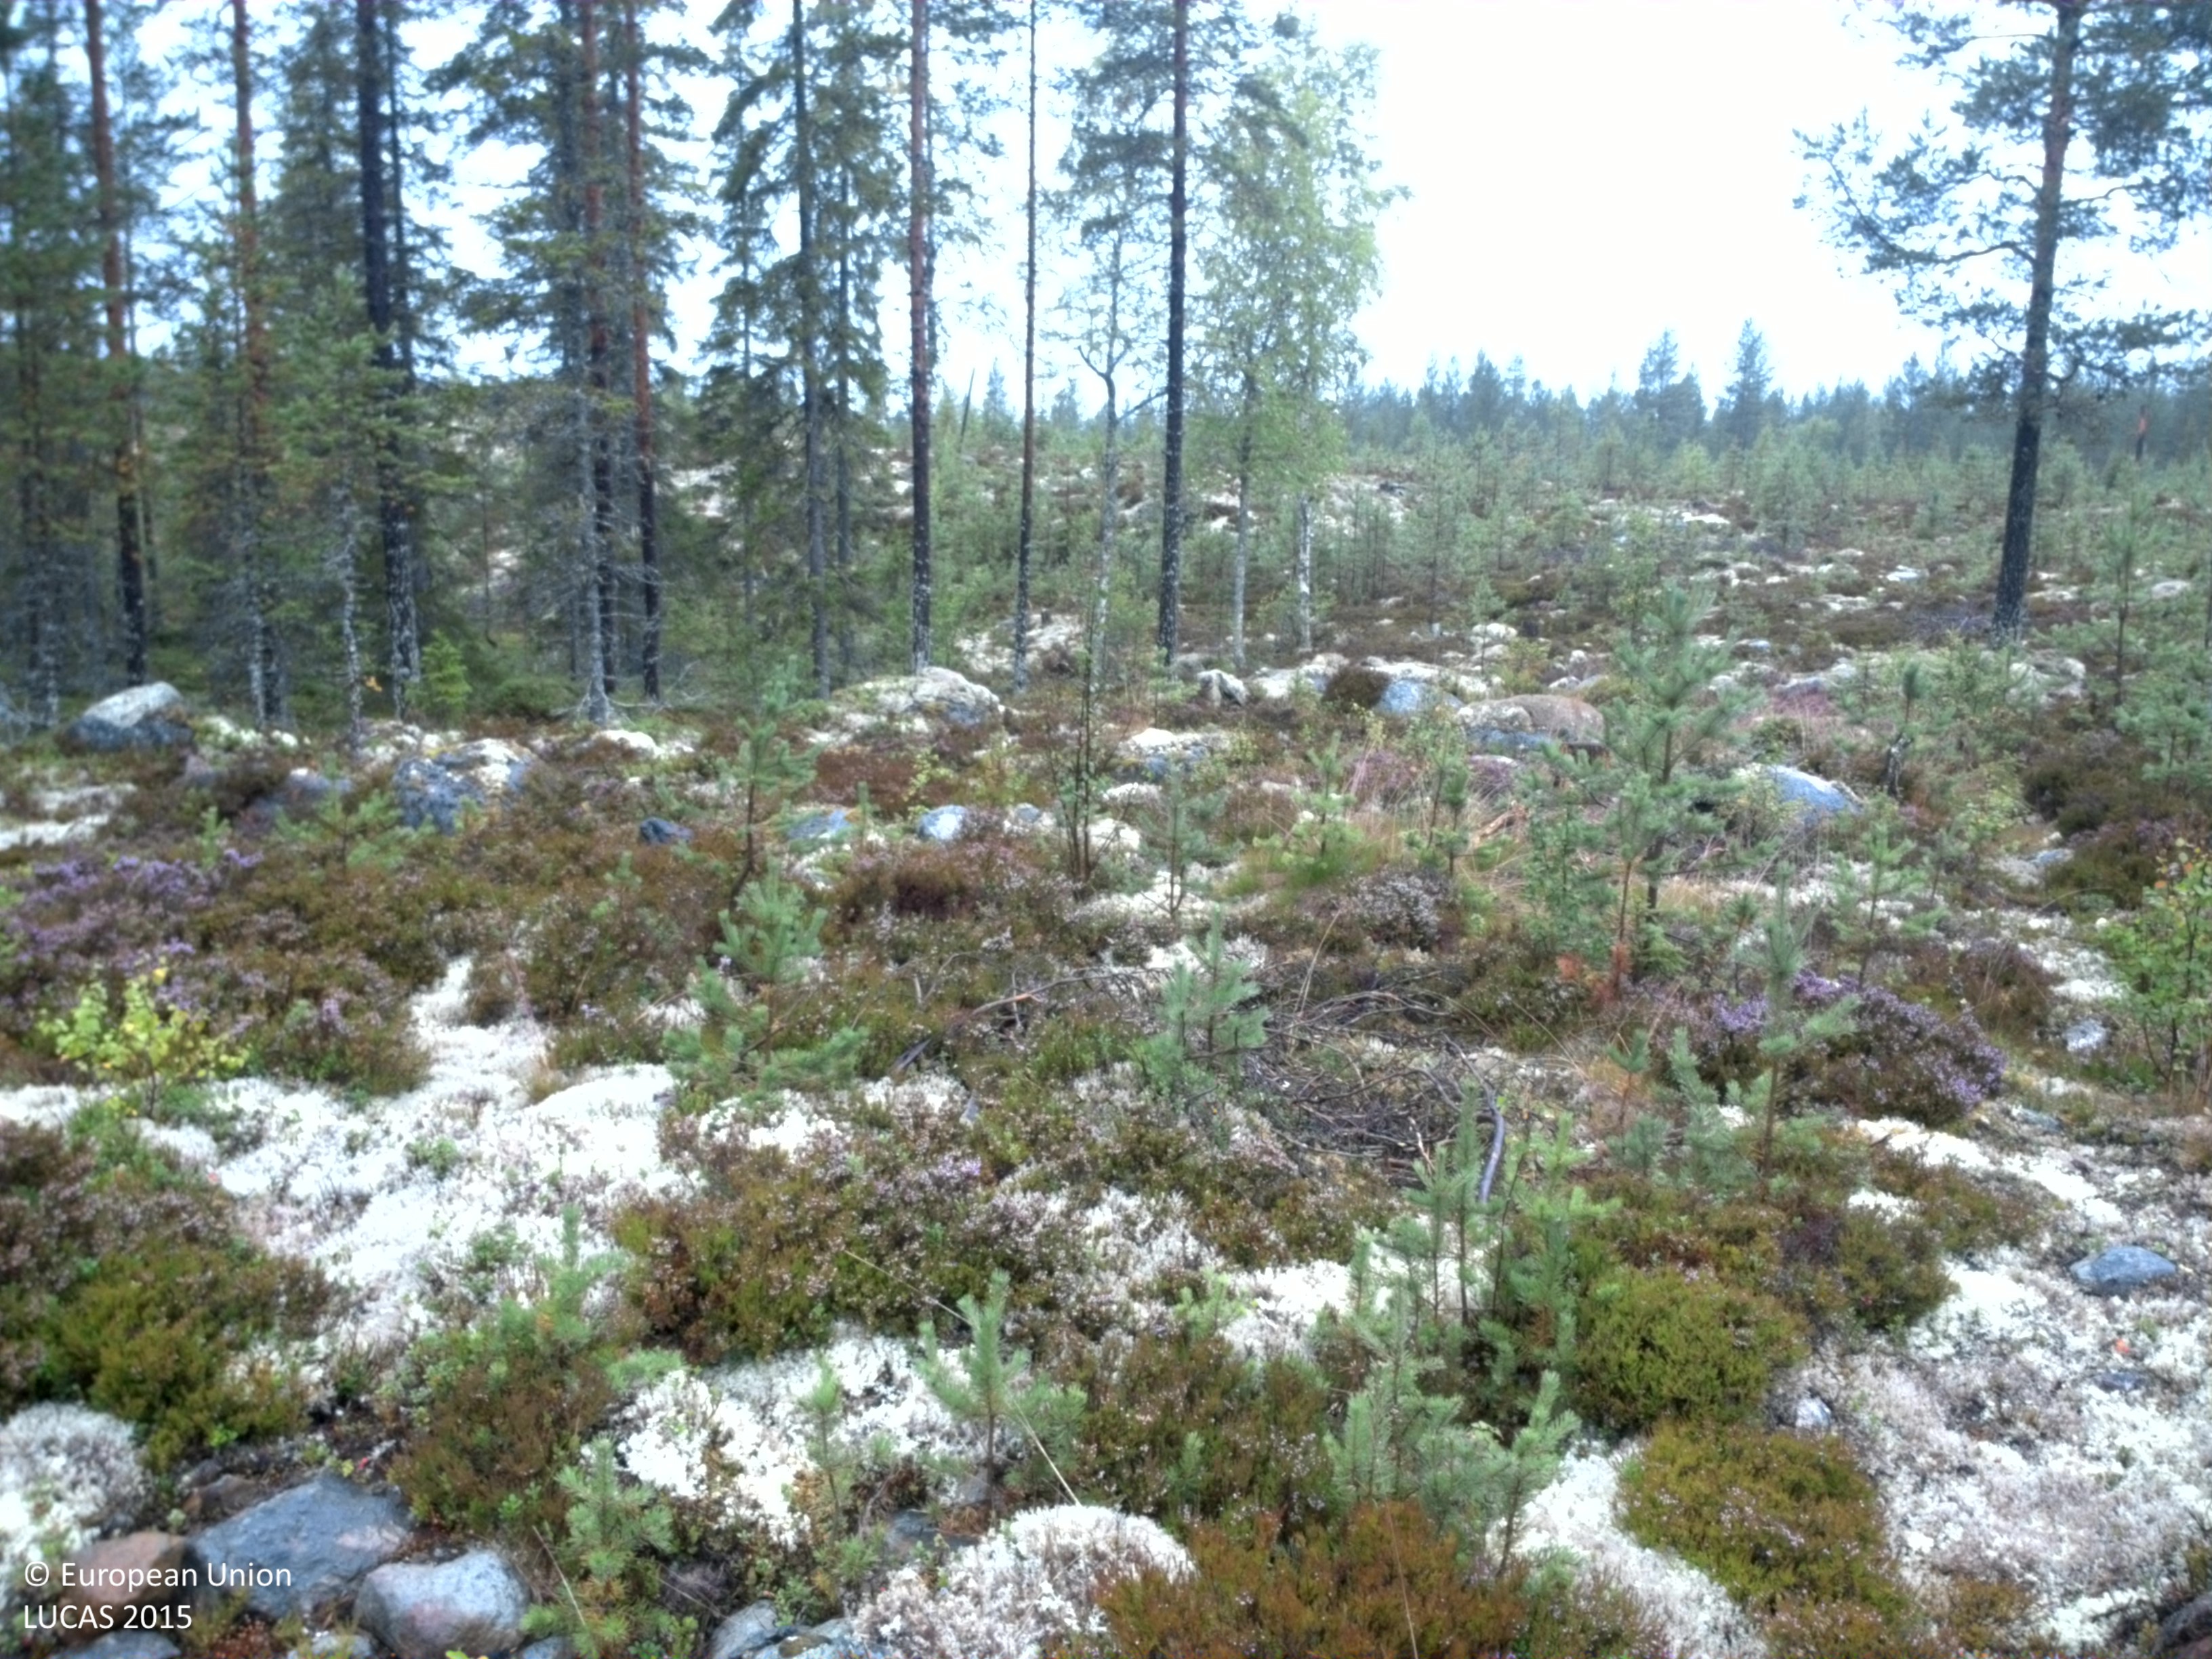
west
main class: Woodland
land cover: Pine dominated coniferous woodland
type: boreal forest
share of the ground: 10 - 25 %
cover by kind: shrubs 65 %, lichens and mosses 20 %, coniferous forest trees 15 %
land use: Forestry
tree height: < 5 m
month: August
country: SE
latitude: 61.7333
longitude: 15.0374
